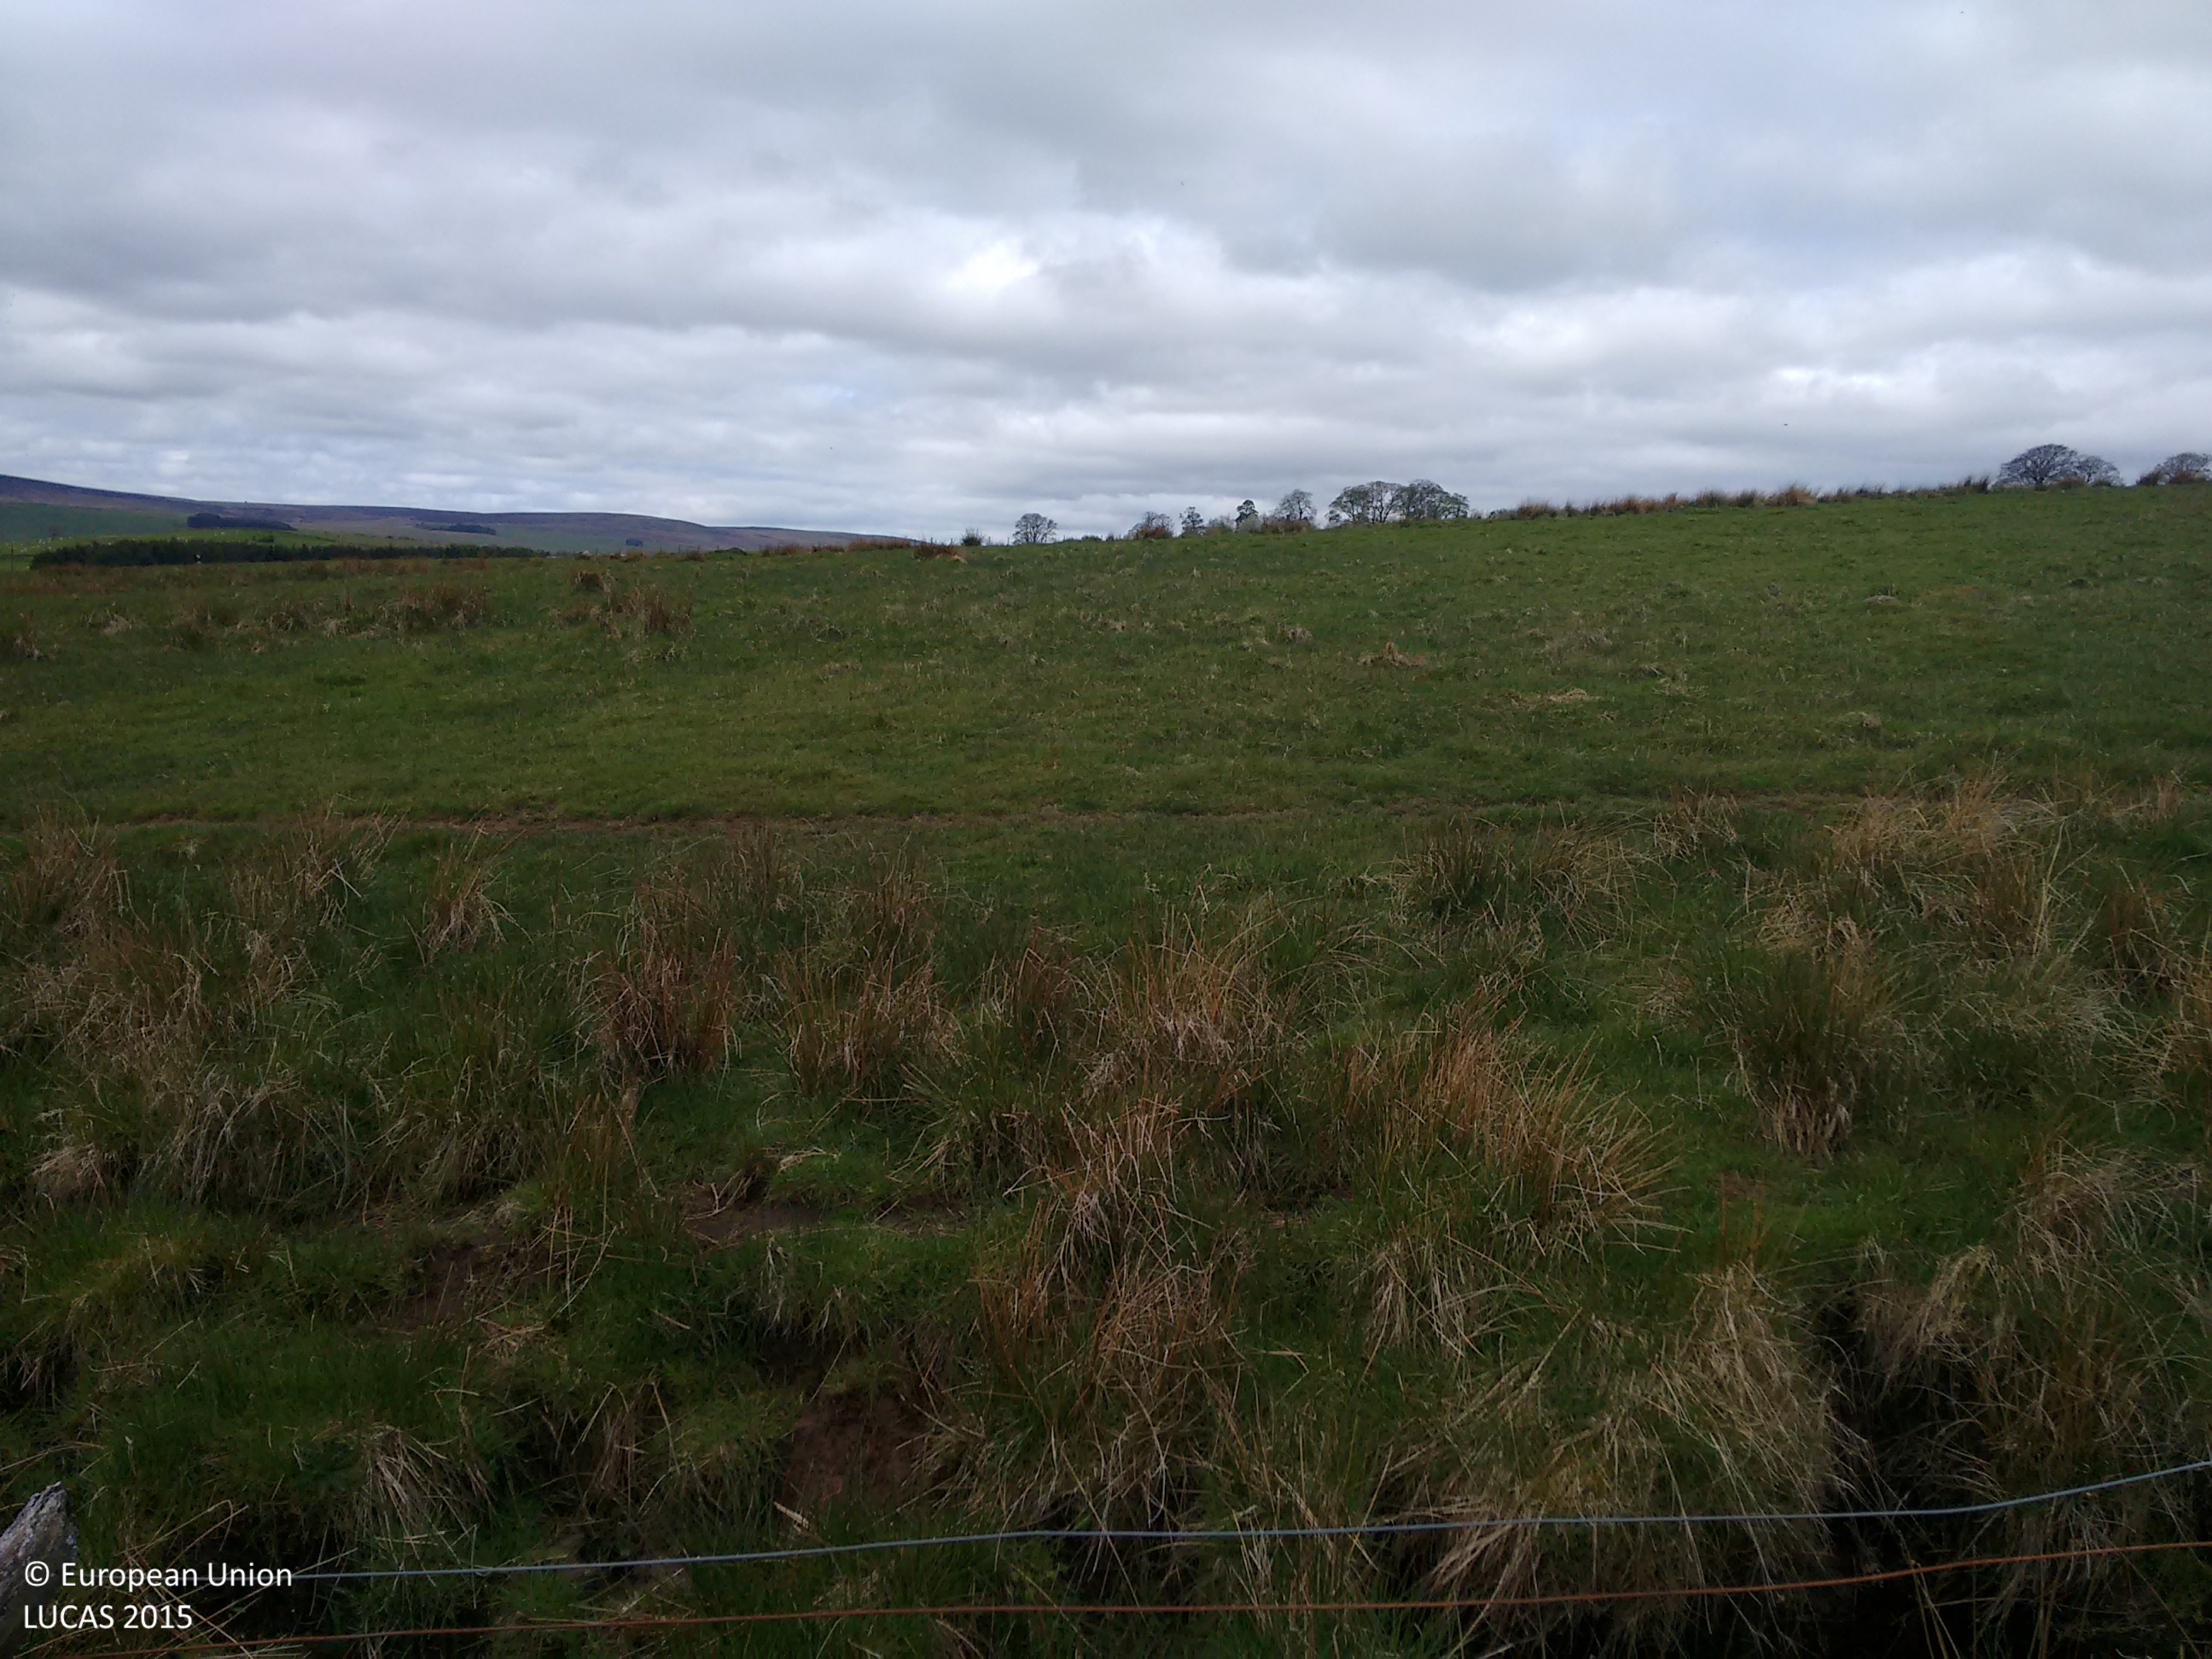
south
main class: Grassland
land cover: Grassland without tree/shrub cover
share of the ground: > 75 %
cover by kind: herbaceous plants 100 %
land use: Agriculture (excluding fallow land and kitchen gardens)
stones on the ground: < 10 %
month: May
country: GB
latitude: 55.2259
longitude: -2.1460
